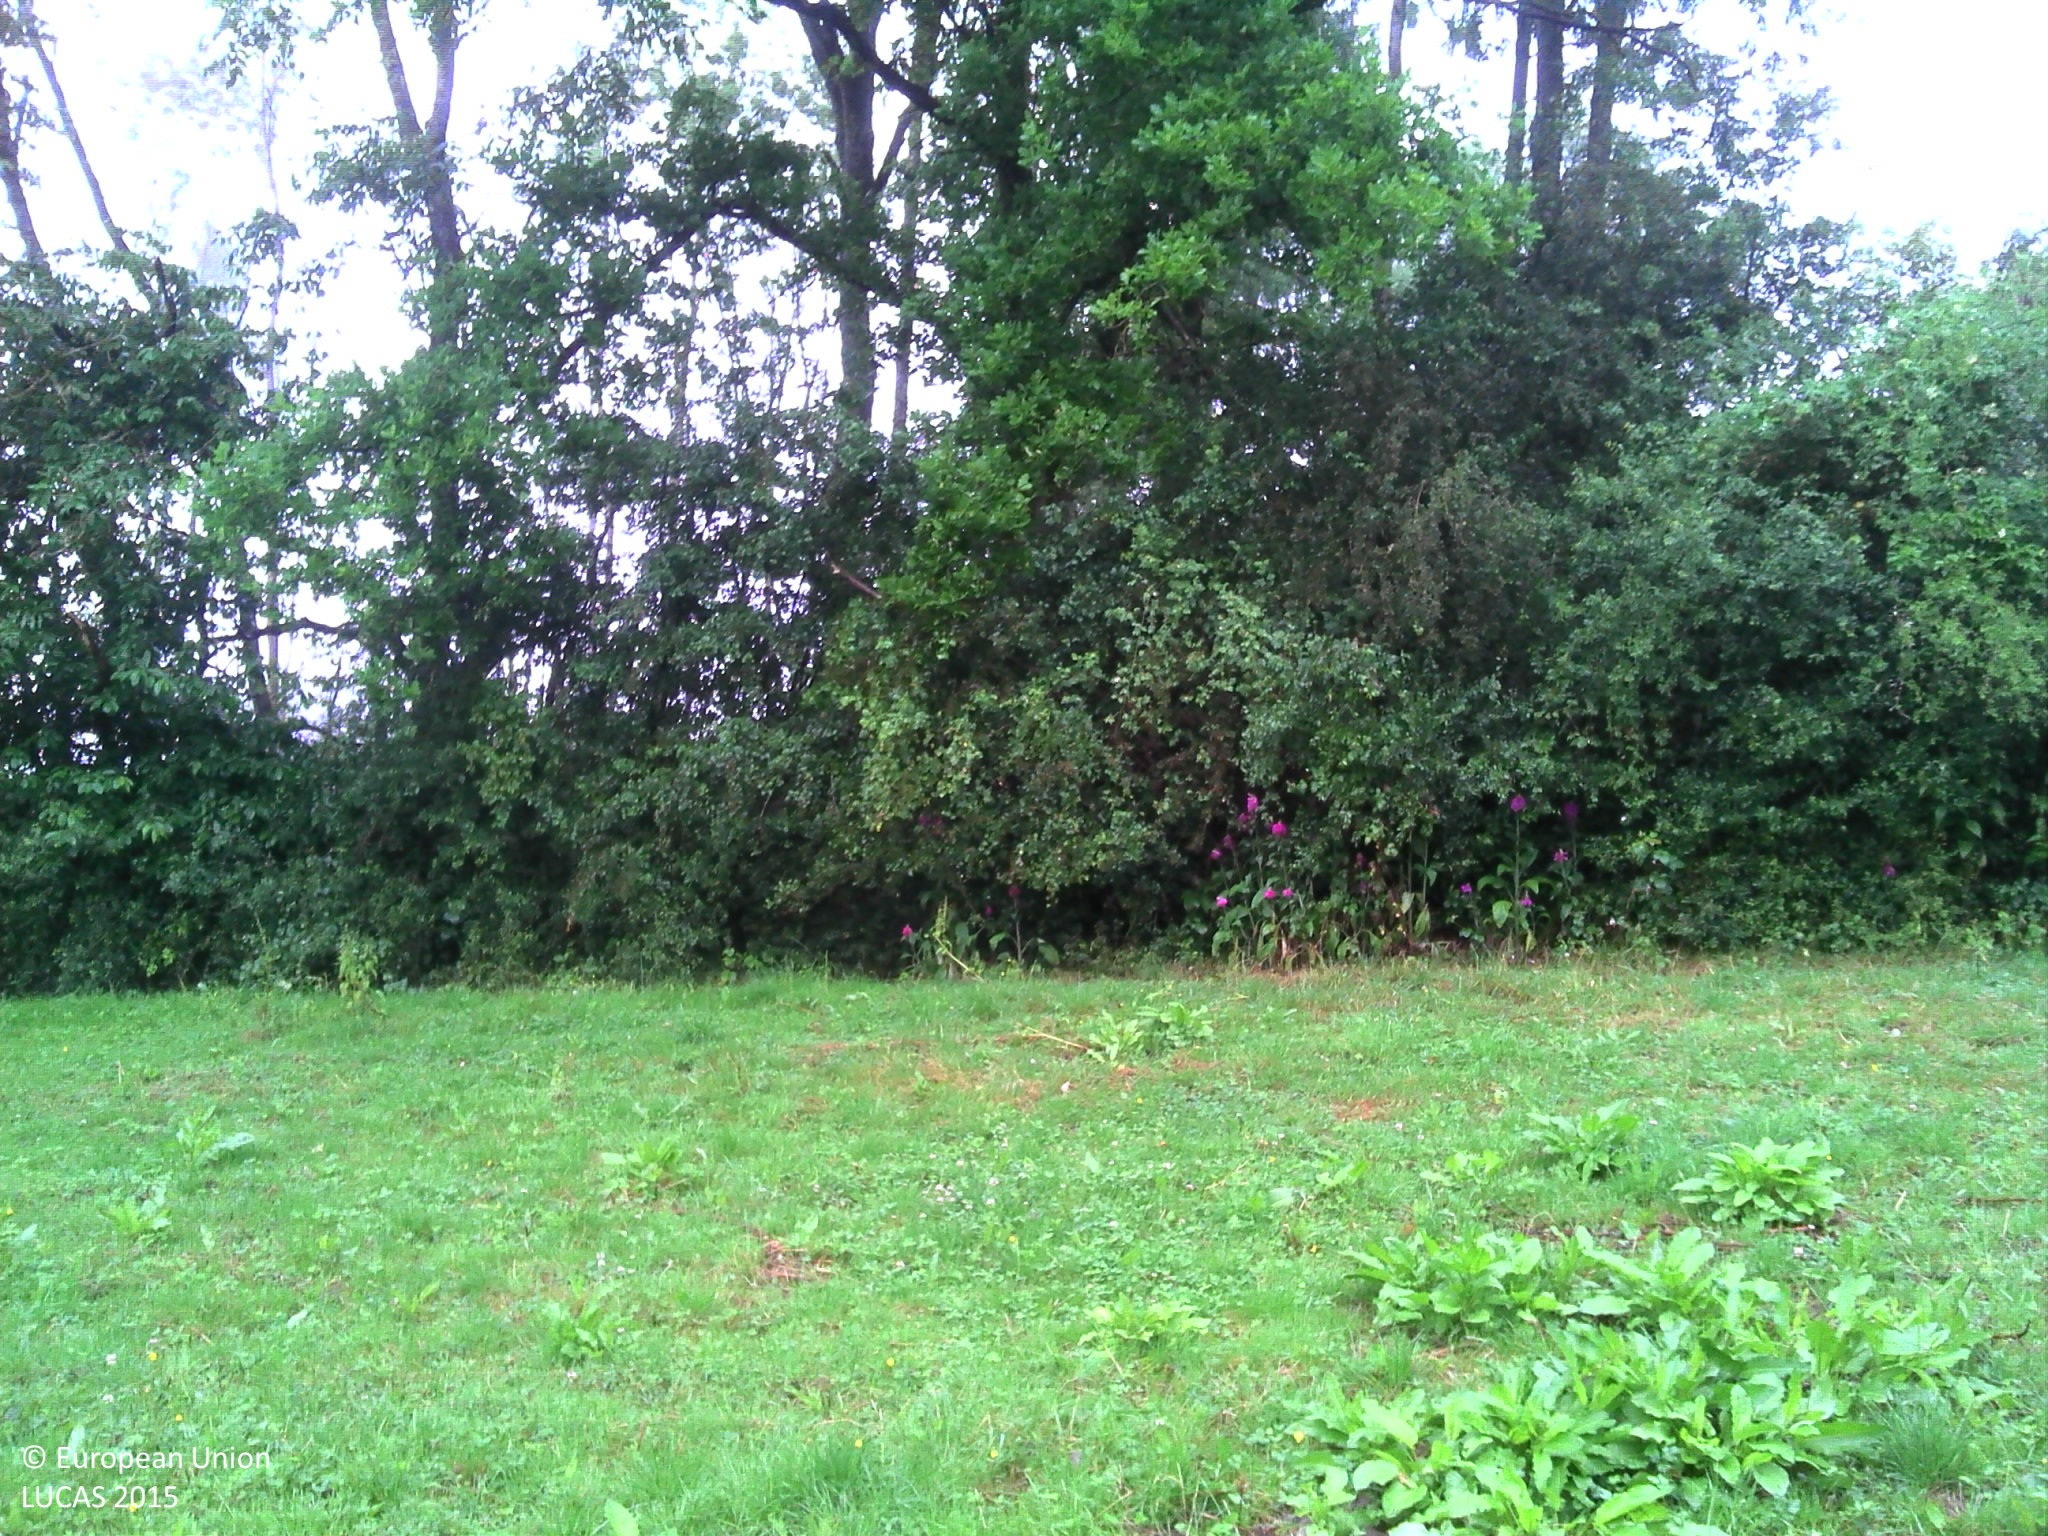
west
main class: Grassland
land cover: Grassland without tree/shrub cover
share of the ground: > 75 %
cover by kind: herbaceous plants 100 %
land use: Agriculture (excluding fallow land and kitchen gardens)
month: June
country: BE
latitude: 50.2585
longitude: 5.5238
